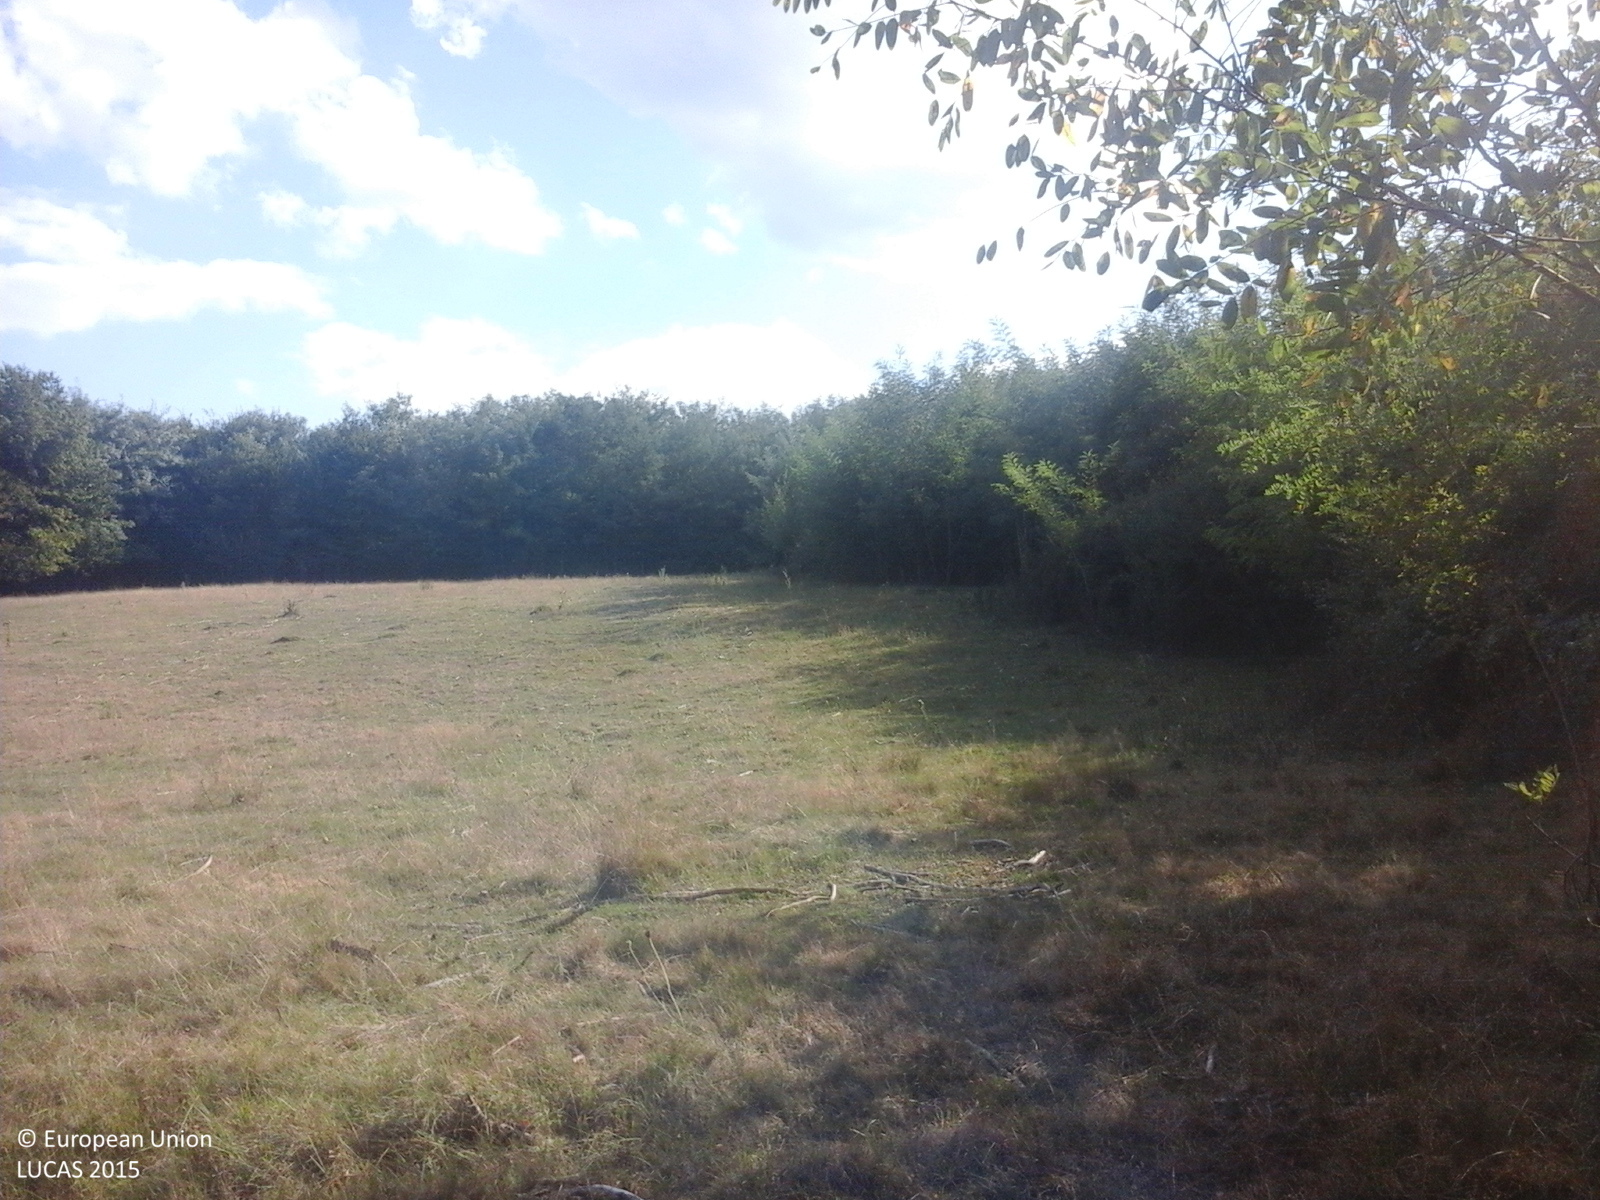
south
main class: Woodland
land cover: Broadleaved woodland
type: exotic forest
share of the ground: > 75 %
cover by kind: broadleaved forest trees 100 %
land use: Forestry
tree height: > 5 m
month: September
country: RO
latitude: 47.4168
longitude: 23.1222
